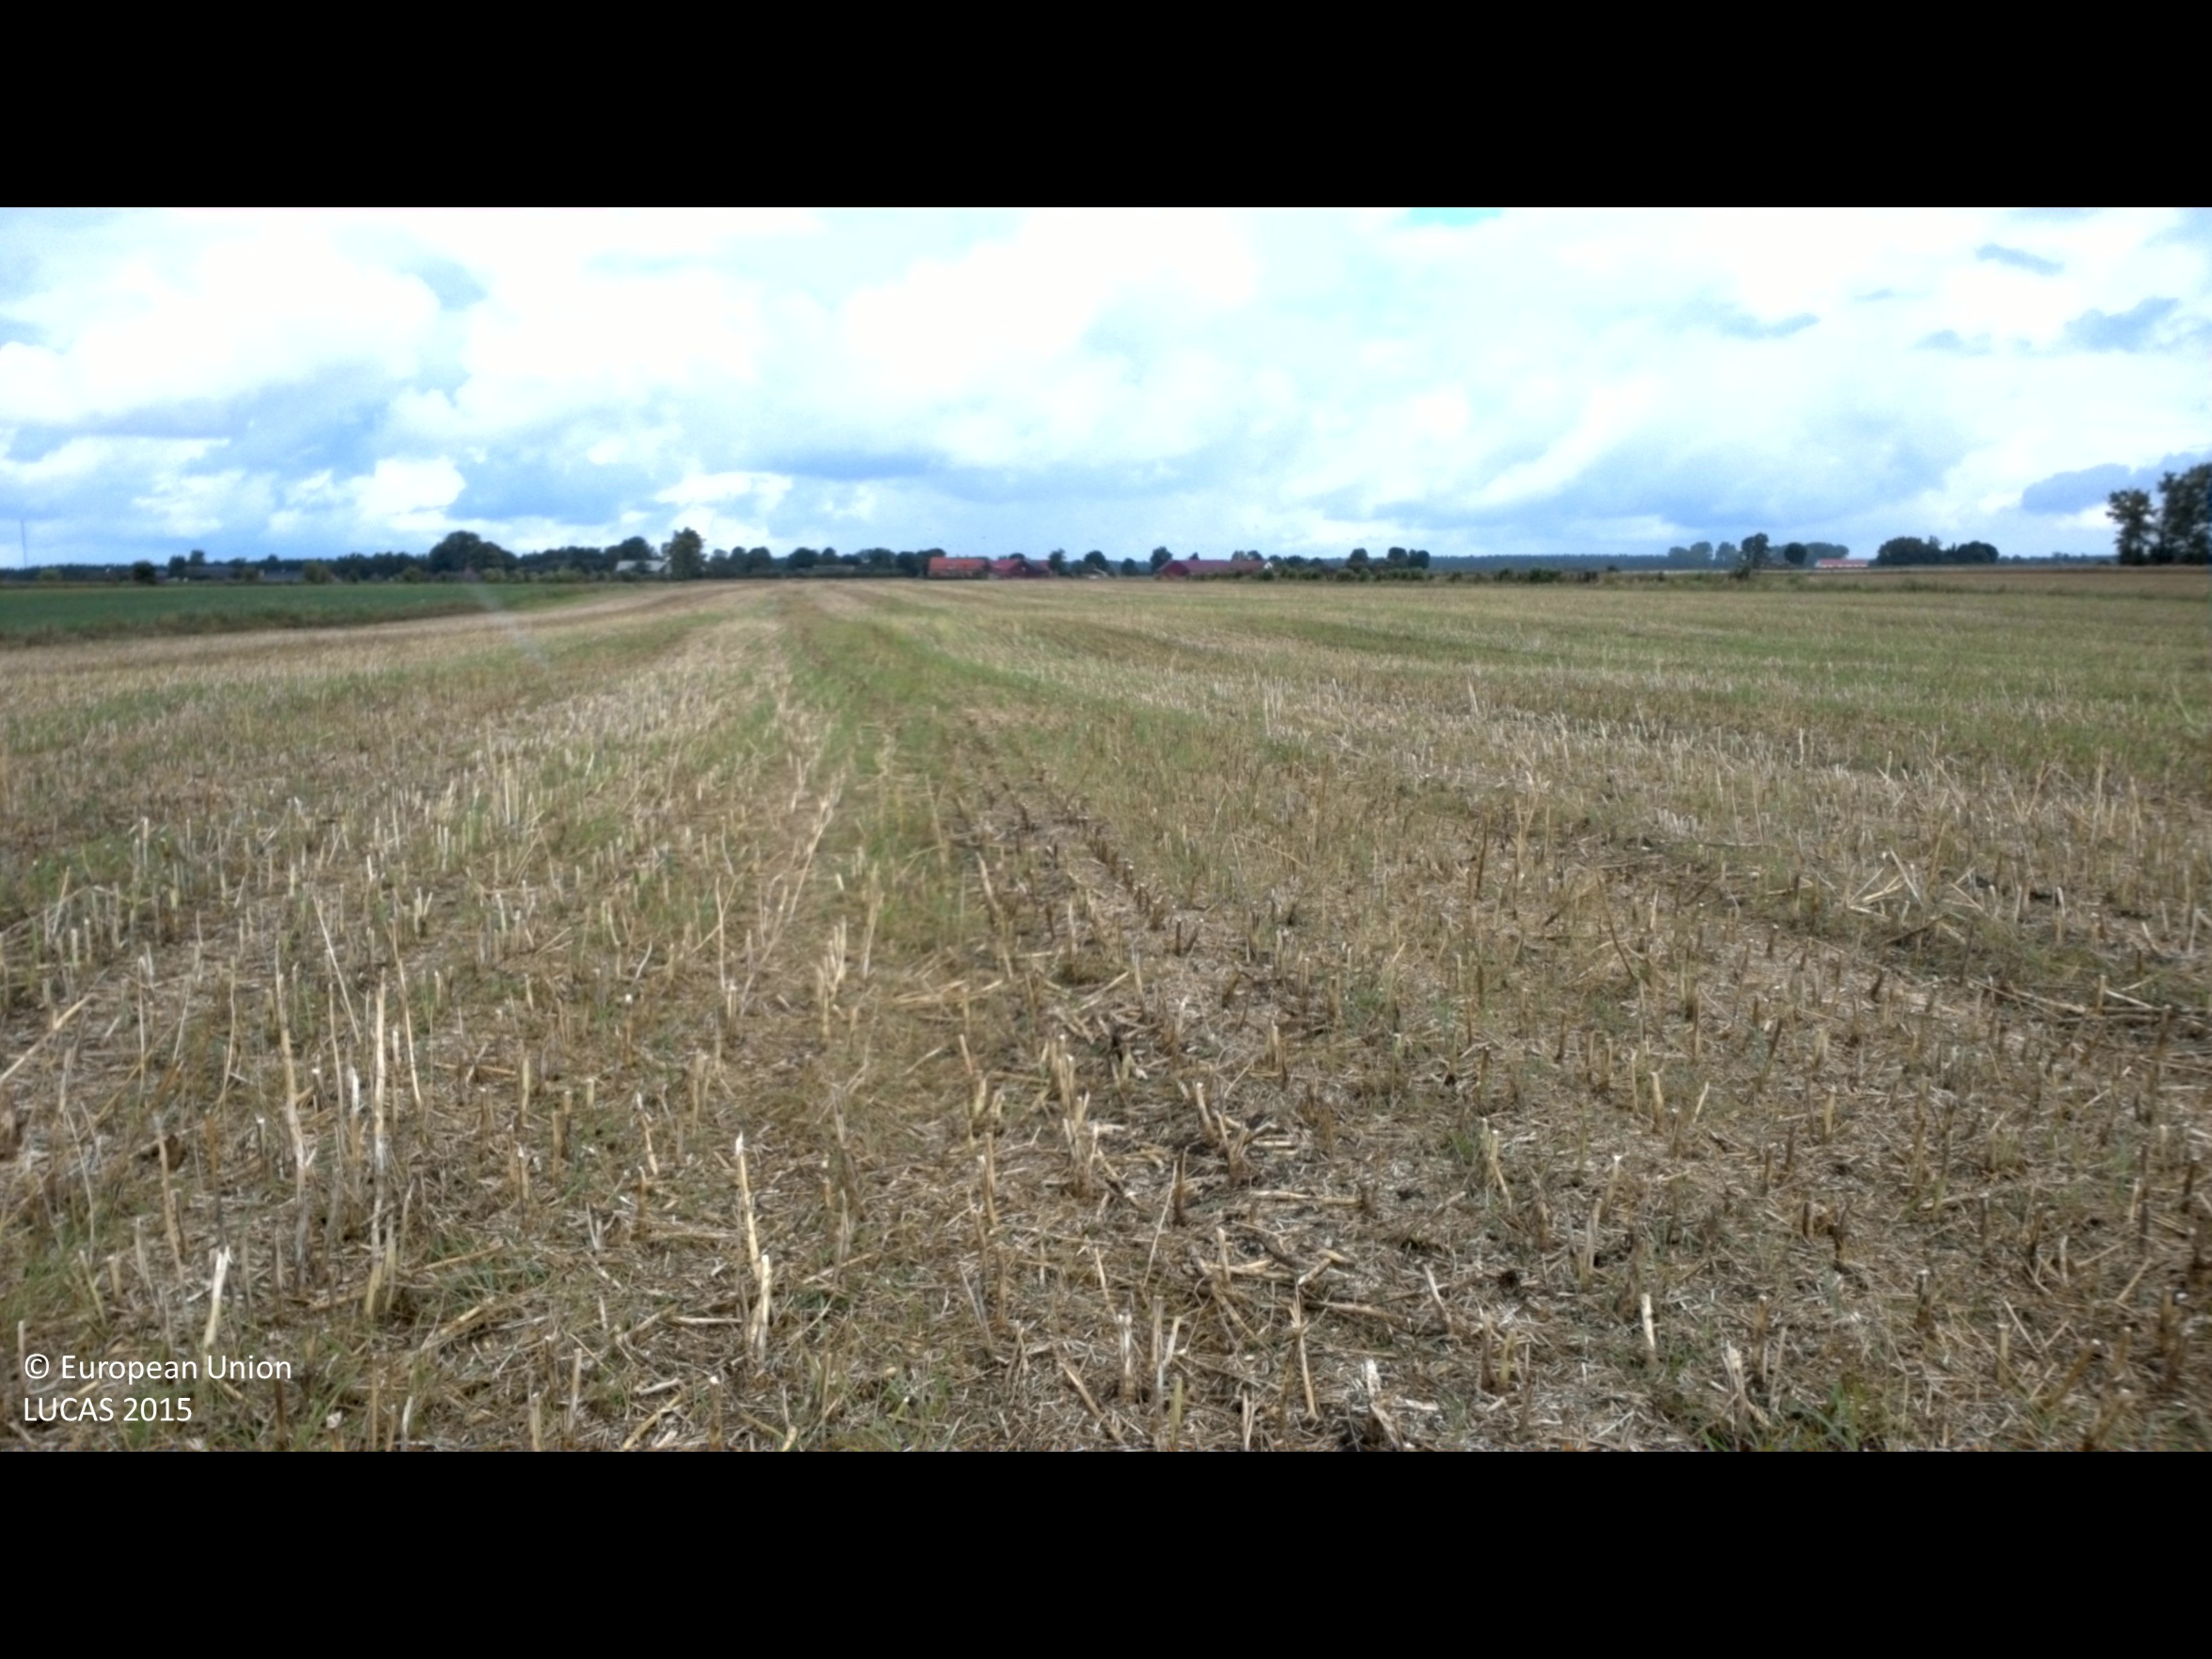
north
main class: Cropland
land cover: Rape and turnip rape
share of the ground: 10 - 25 %
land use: Agriculture (excluding fallow land and kitchen gardens)
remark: Harvested field
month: July
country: SE
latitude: 55.9019
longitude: 14.2366
